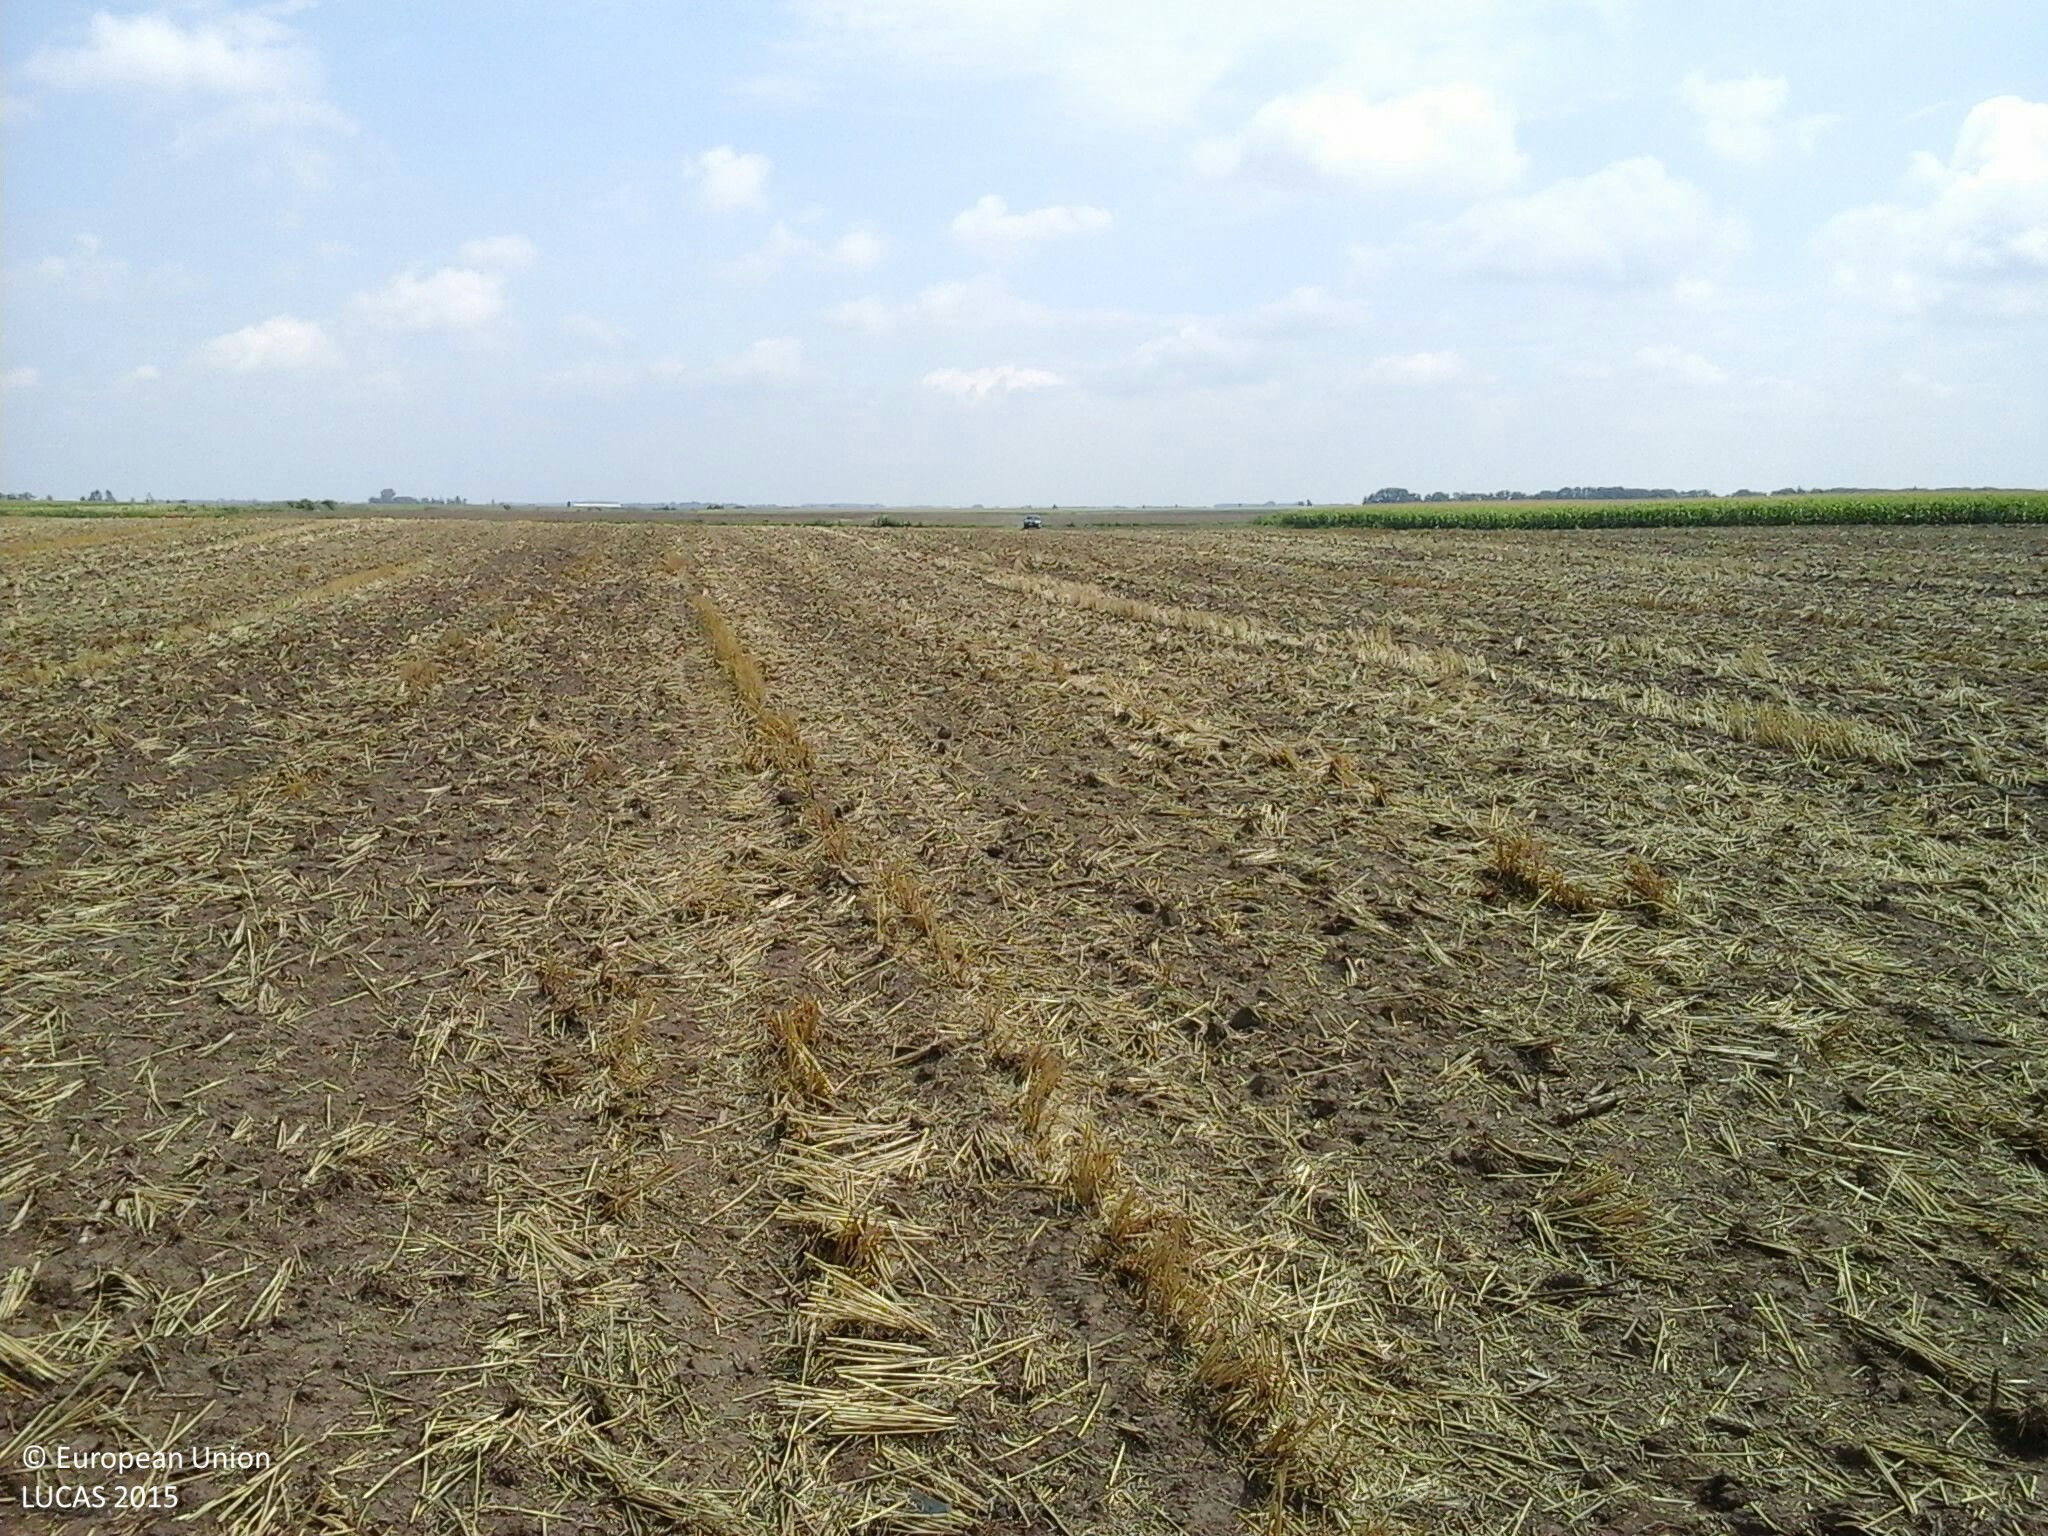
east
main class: Cropland
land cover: Common wheat
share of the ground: 10 - 25 %
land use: Agriculture (excluding fallow land and kitchen gardens)
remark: Harvested field
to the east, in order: Common wheat; Tracks
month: July
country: HU
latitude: 47.8997
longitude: 21.4274
